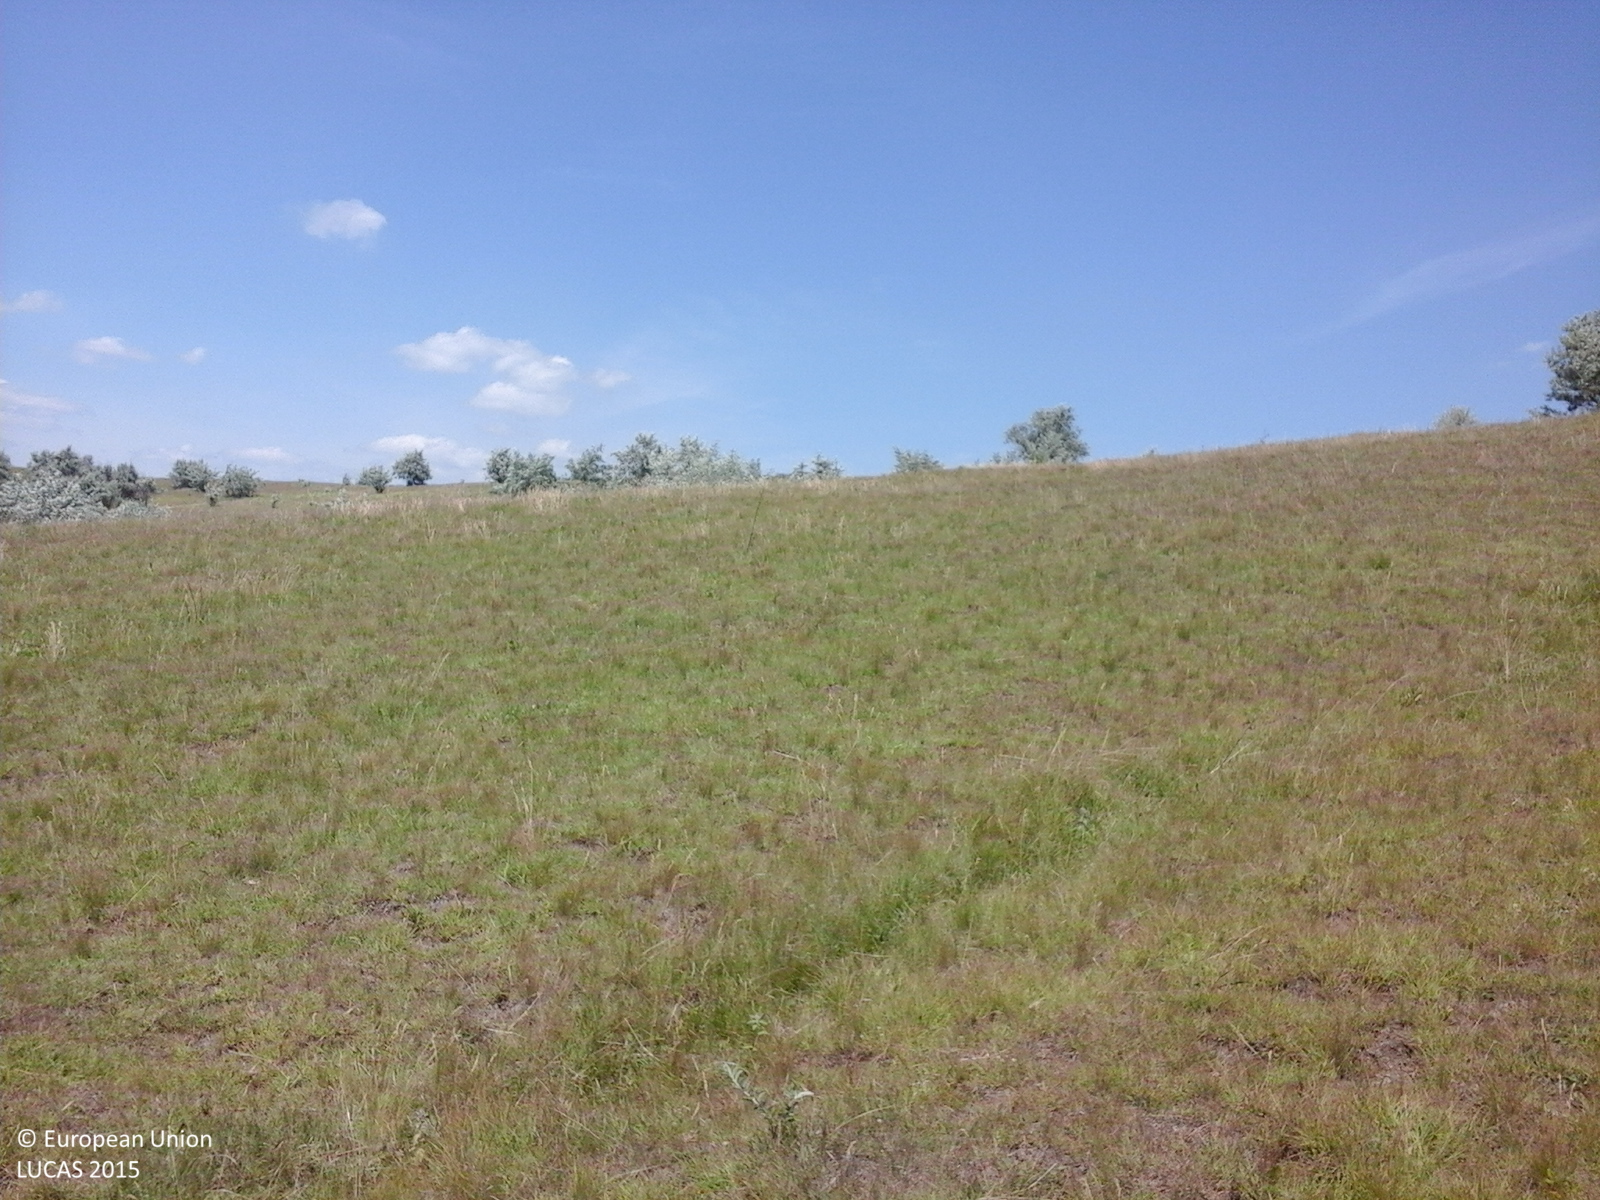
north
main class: Grassland
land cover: Grassland without tree/shrub cover
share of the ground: > 75 %
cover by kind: herbaceous plants 100 %
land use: Agriculture (excluding fallow land and kitchen gardens)
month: June
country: RO
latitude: 48.1463
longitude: 26.7252
